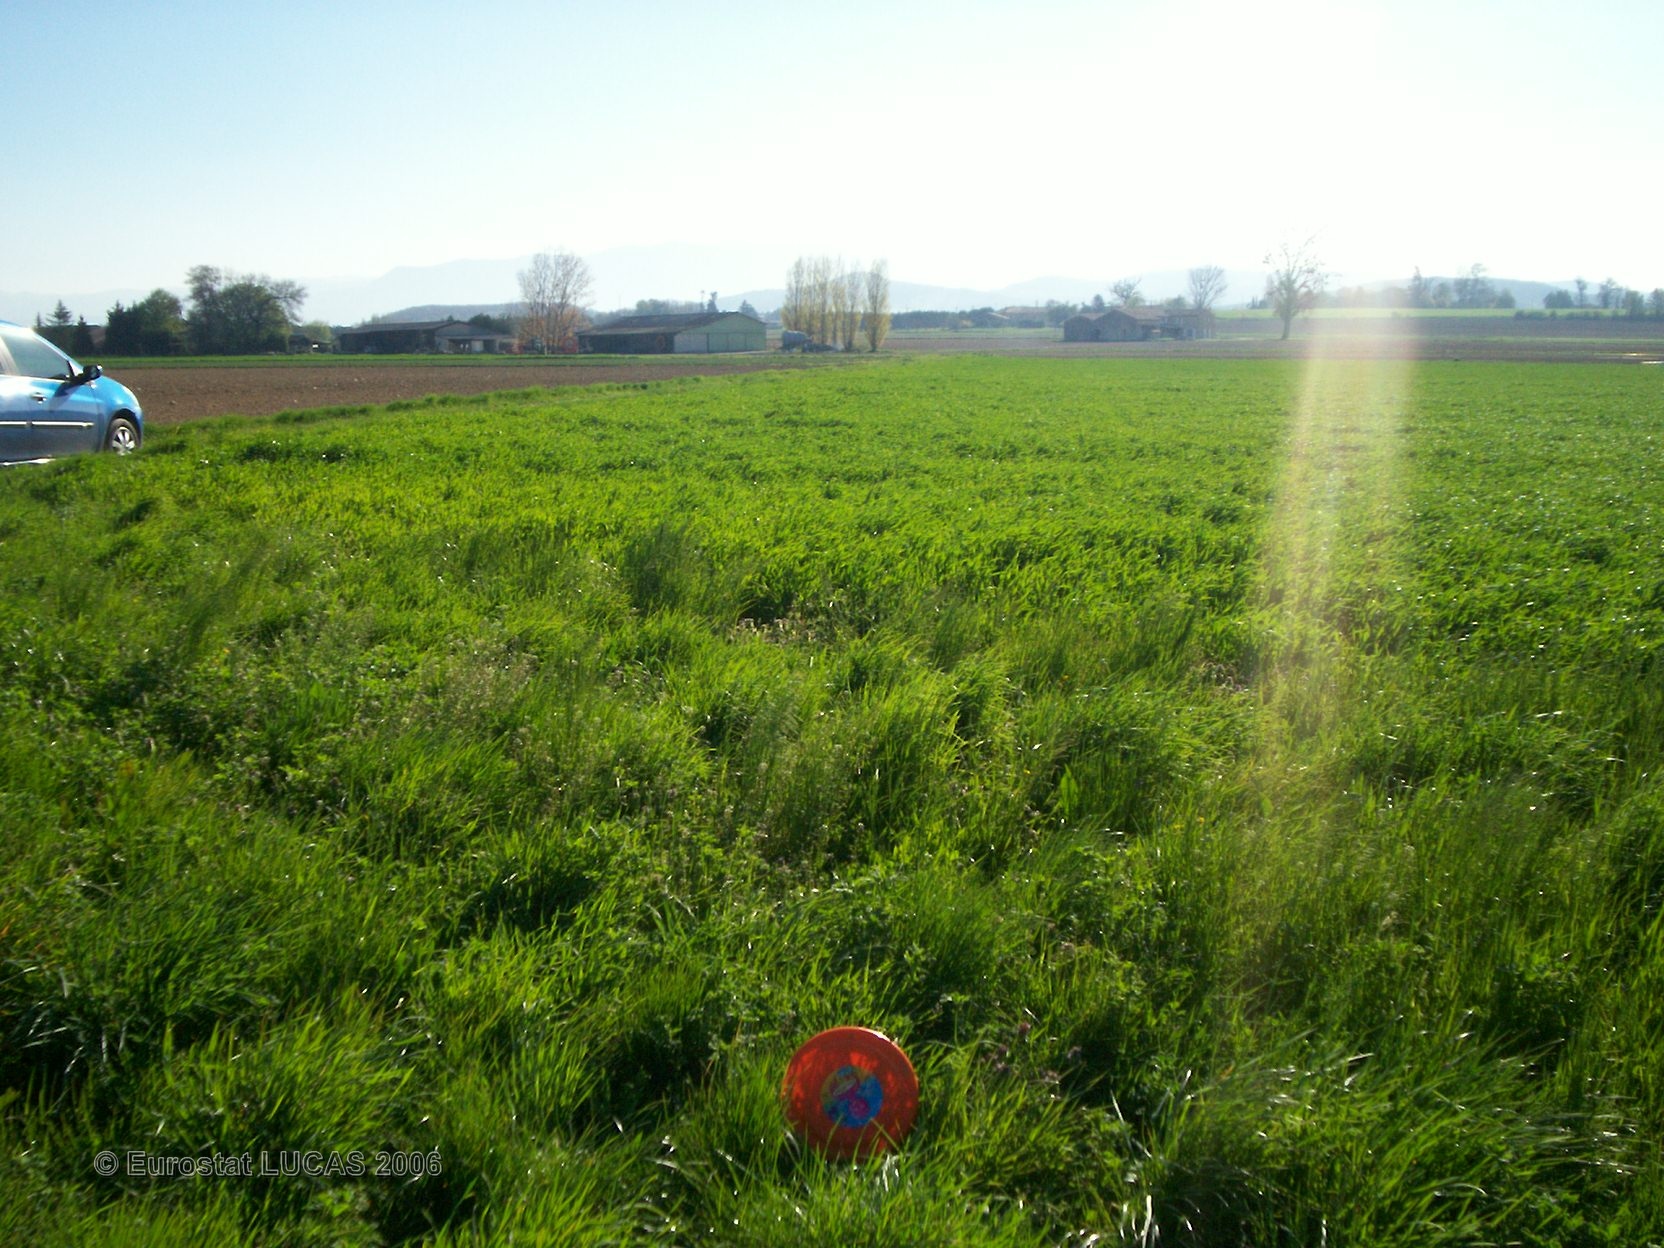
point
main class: Grassland
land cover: Grassland without tree/shrub cover
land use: Agriculture (excluding fallow land and kitchen gardens)
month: April
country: FR
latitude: 44.7858
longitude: 4.9127
